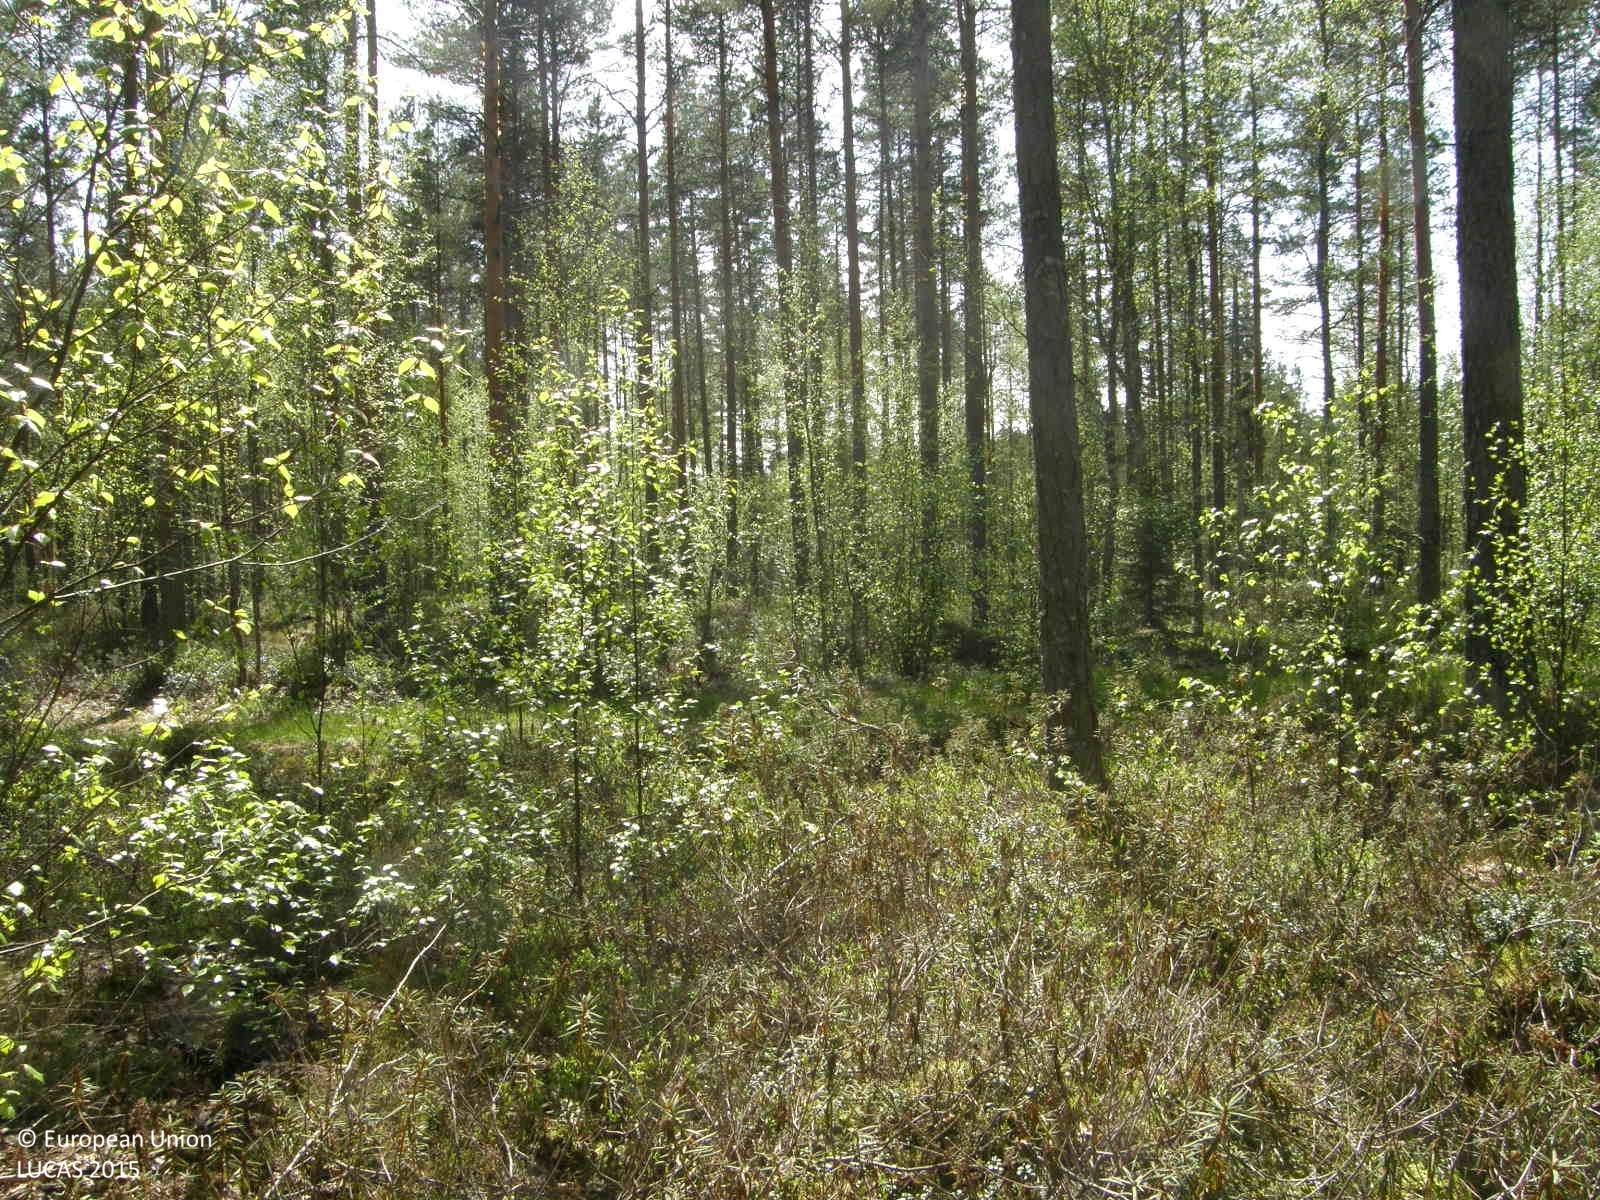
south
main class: Woodland
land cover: Pine dominated coniferous woodland
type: boreal forest
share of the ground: > 75 %
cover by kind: coniferous forest trees 75 %, shrubs 15 %, broadleaved forest trees 10 %
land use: Forestry
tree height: > 5 m
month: June
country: FI
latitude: 62.1590
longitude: 22.3209
